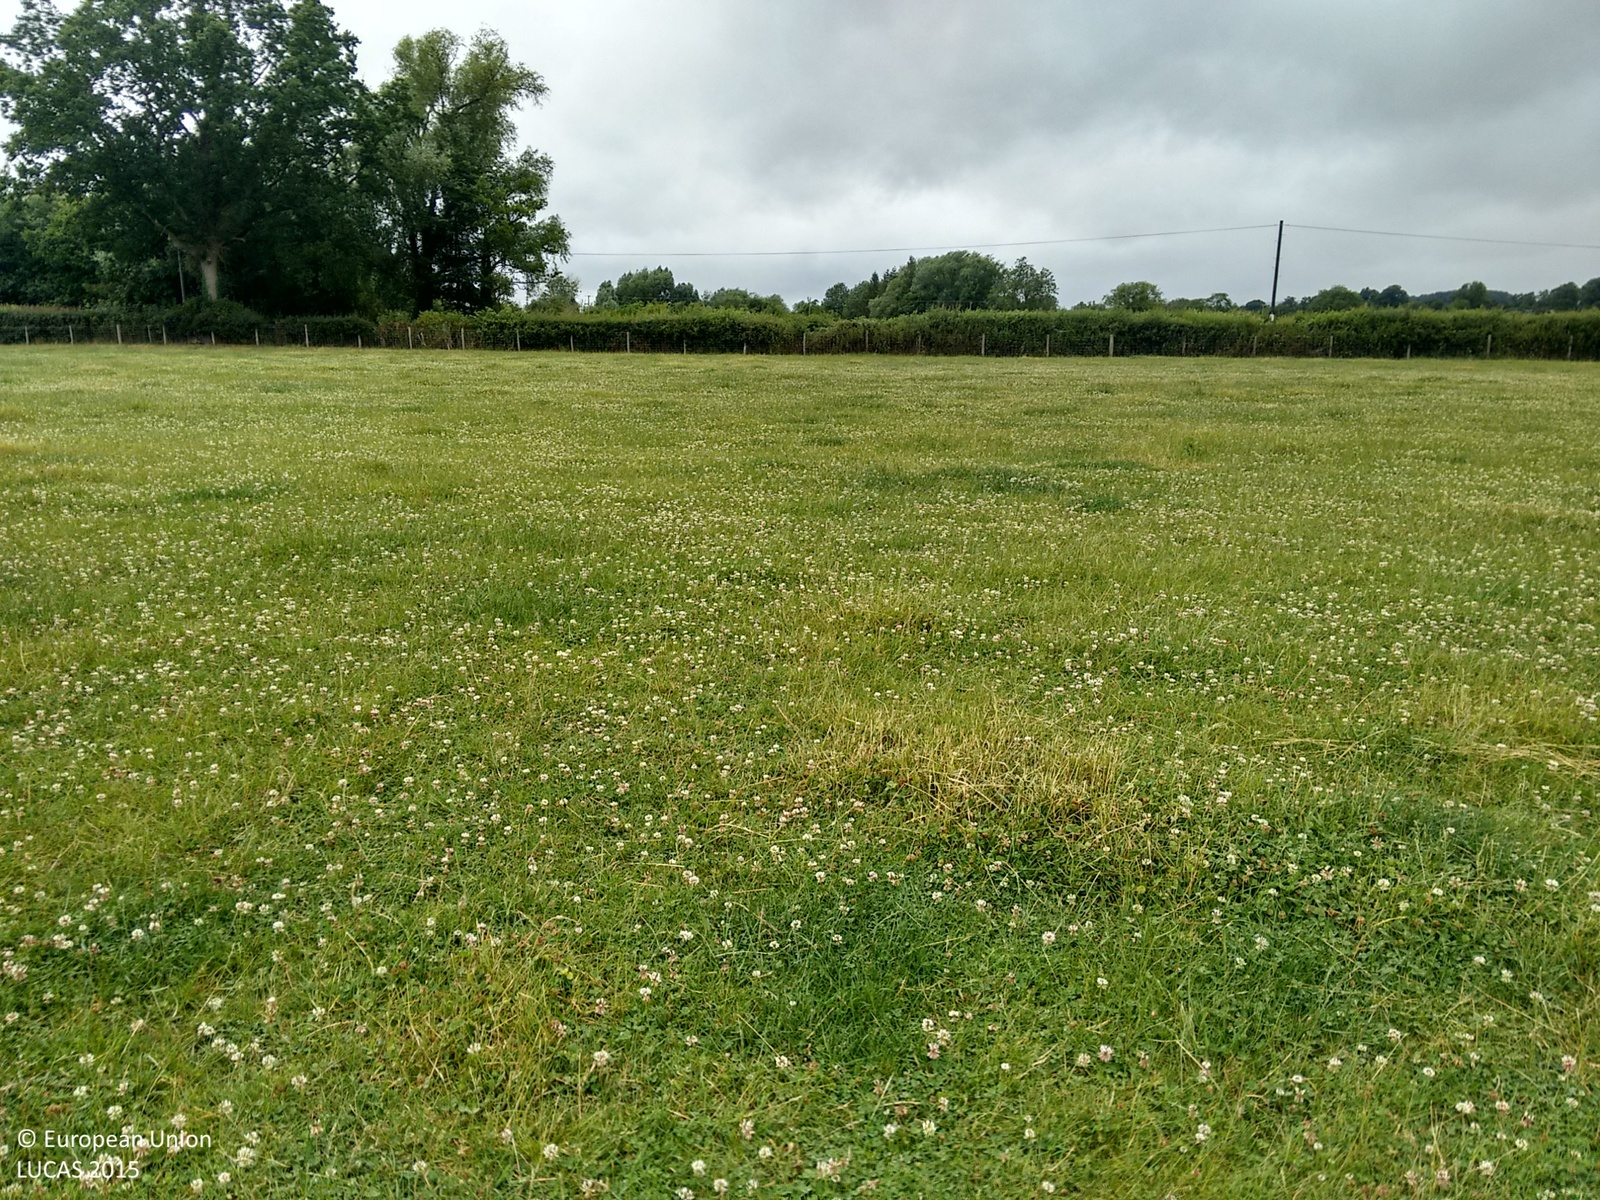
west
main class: Grassland
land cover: Grassland without tree/shrub cover
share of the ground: > 75 %
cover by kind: herbaceous plants 100 %
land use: Agriculture (excluding fallow land and kitchen gardens)
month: July
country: GB
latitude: 52.2248
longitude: -2.8228
